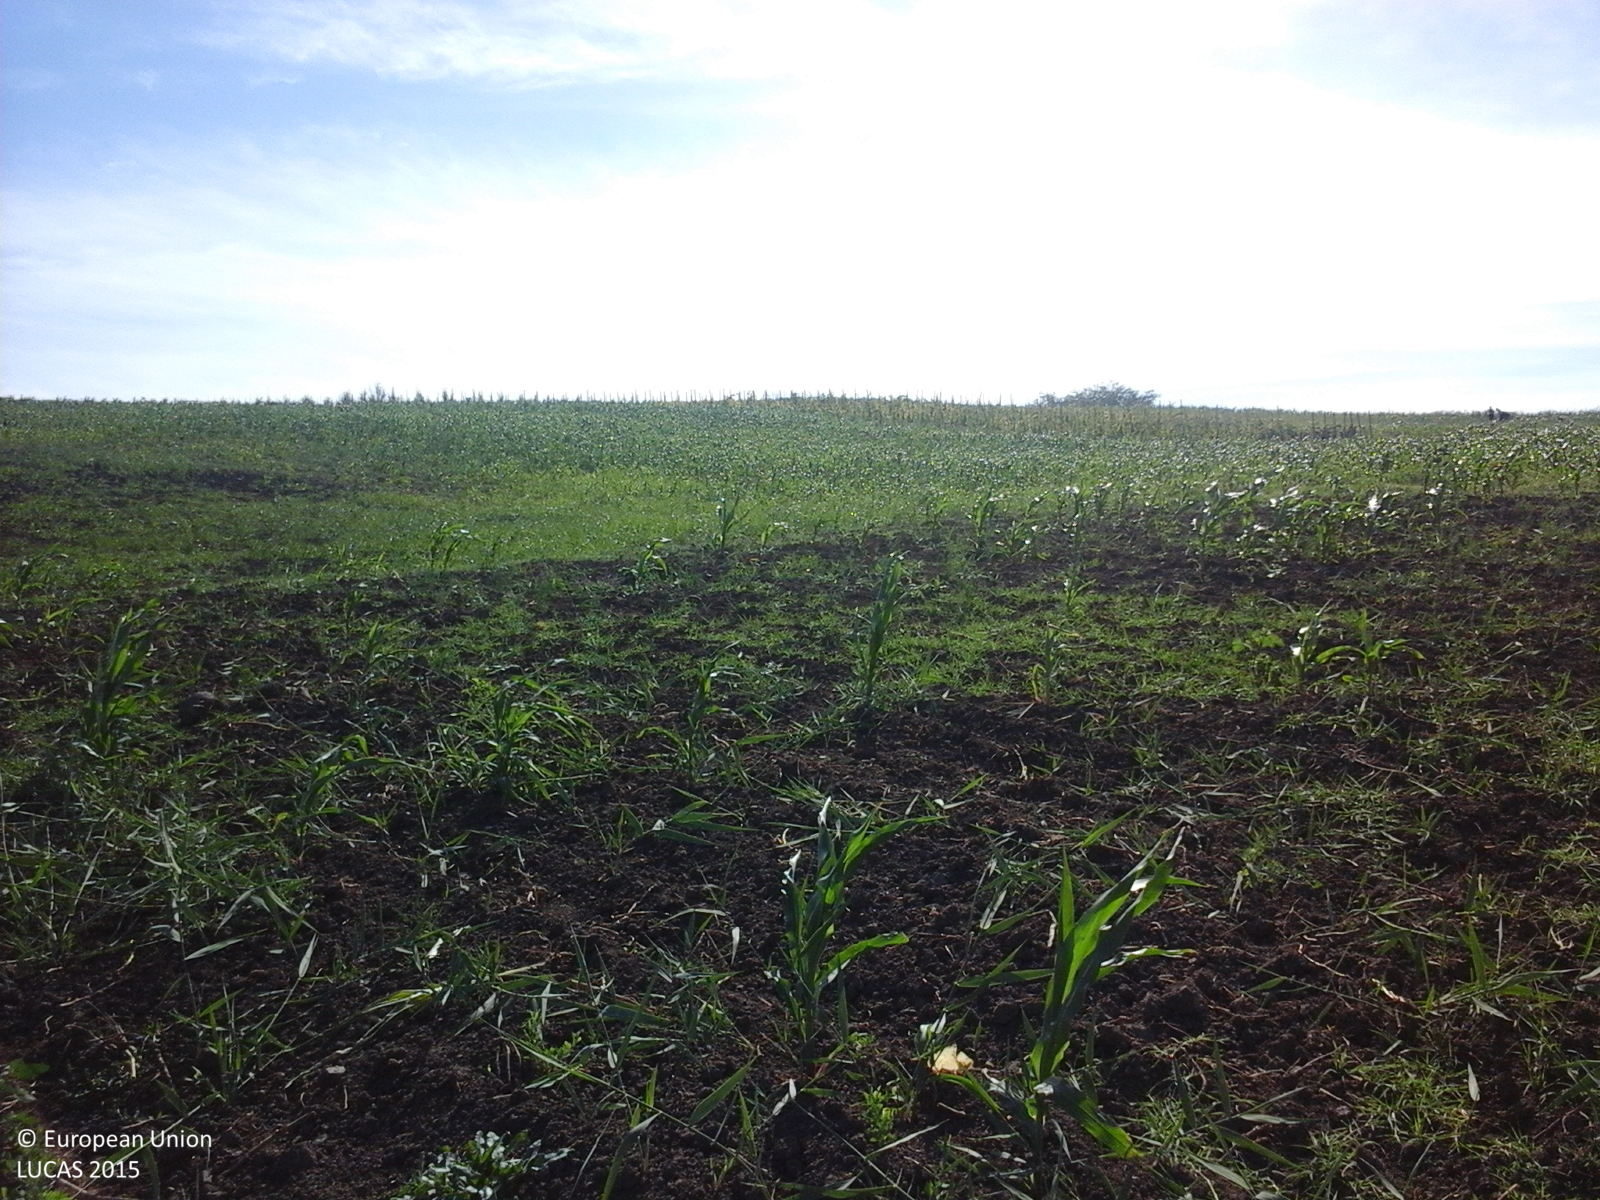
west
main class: Cropland
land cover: Maize
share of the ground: 25 - 50 %
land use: Agriculture (excluding fallow land and kitchen gardens)
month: June
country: RO
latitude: 47.3056
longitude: 27.0464
